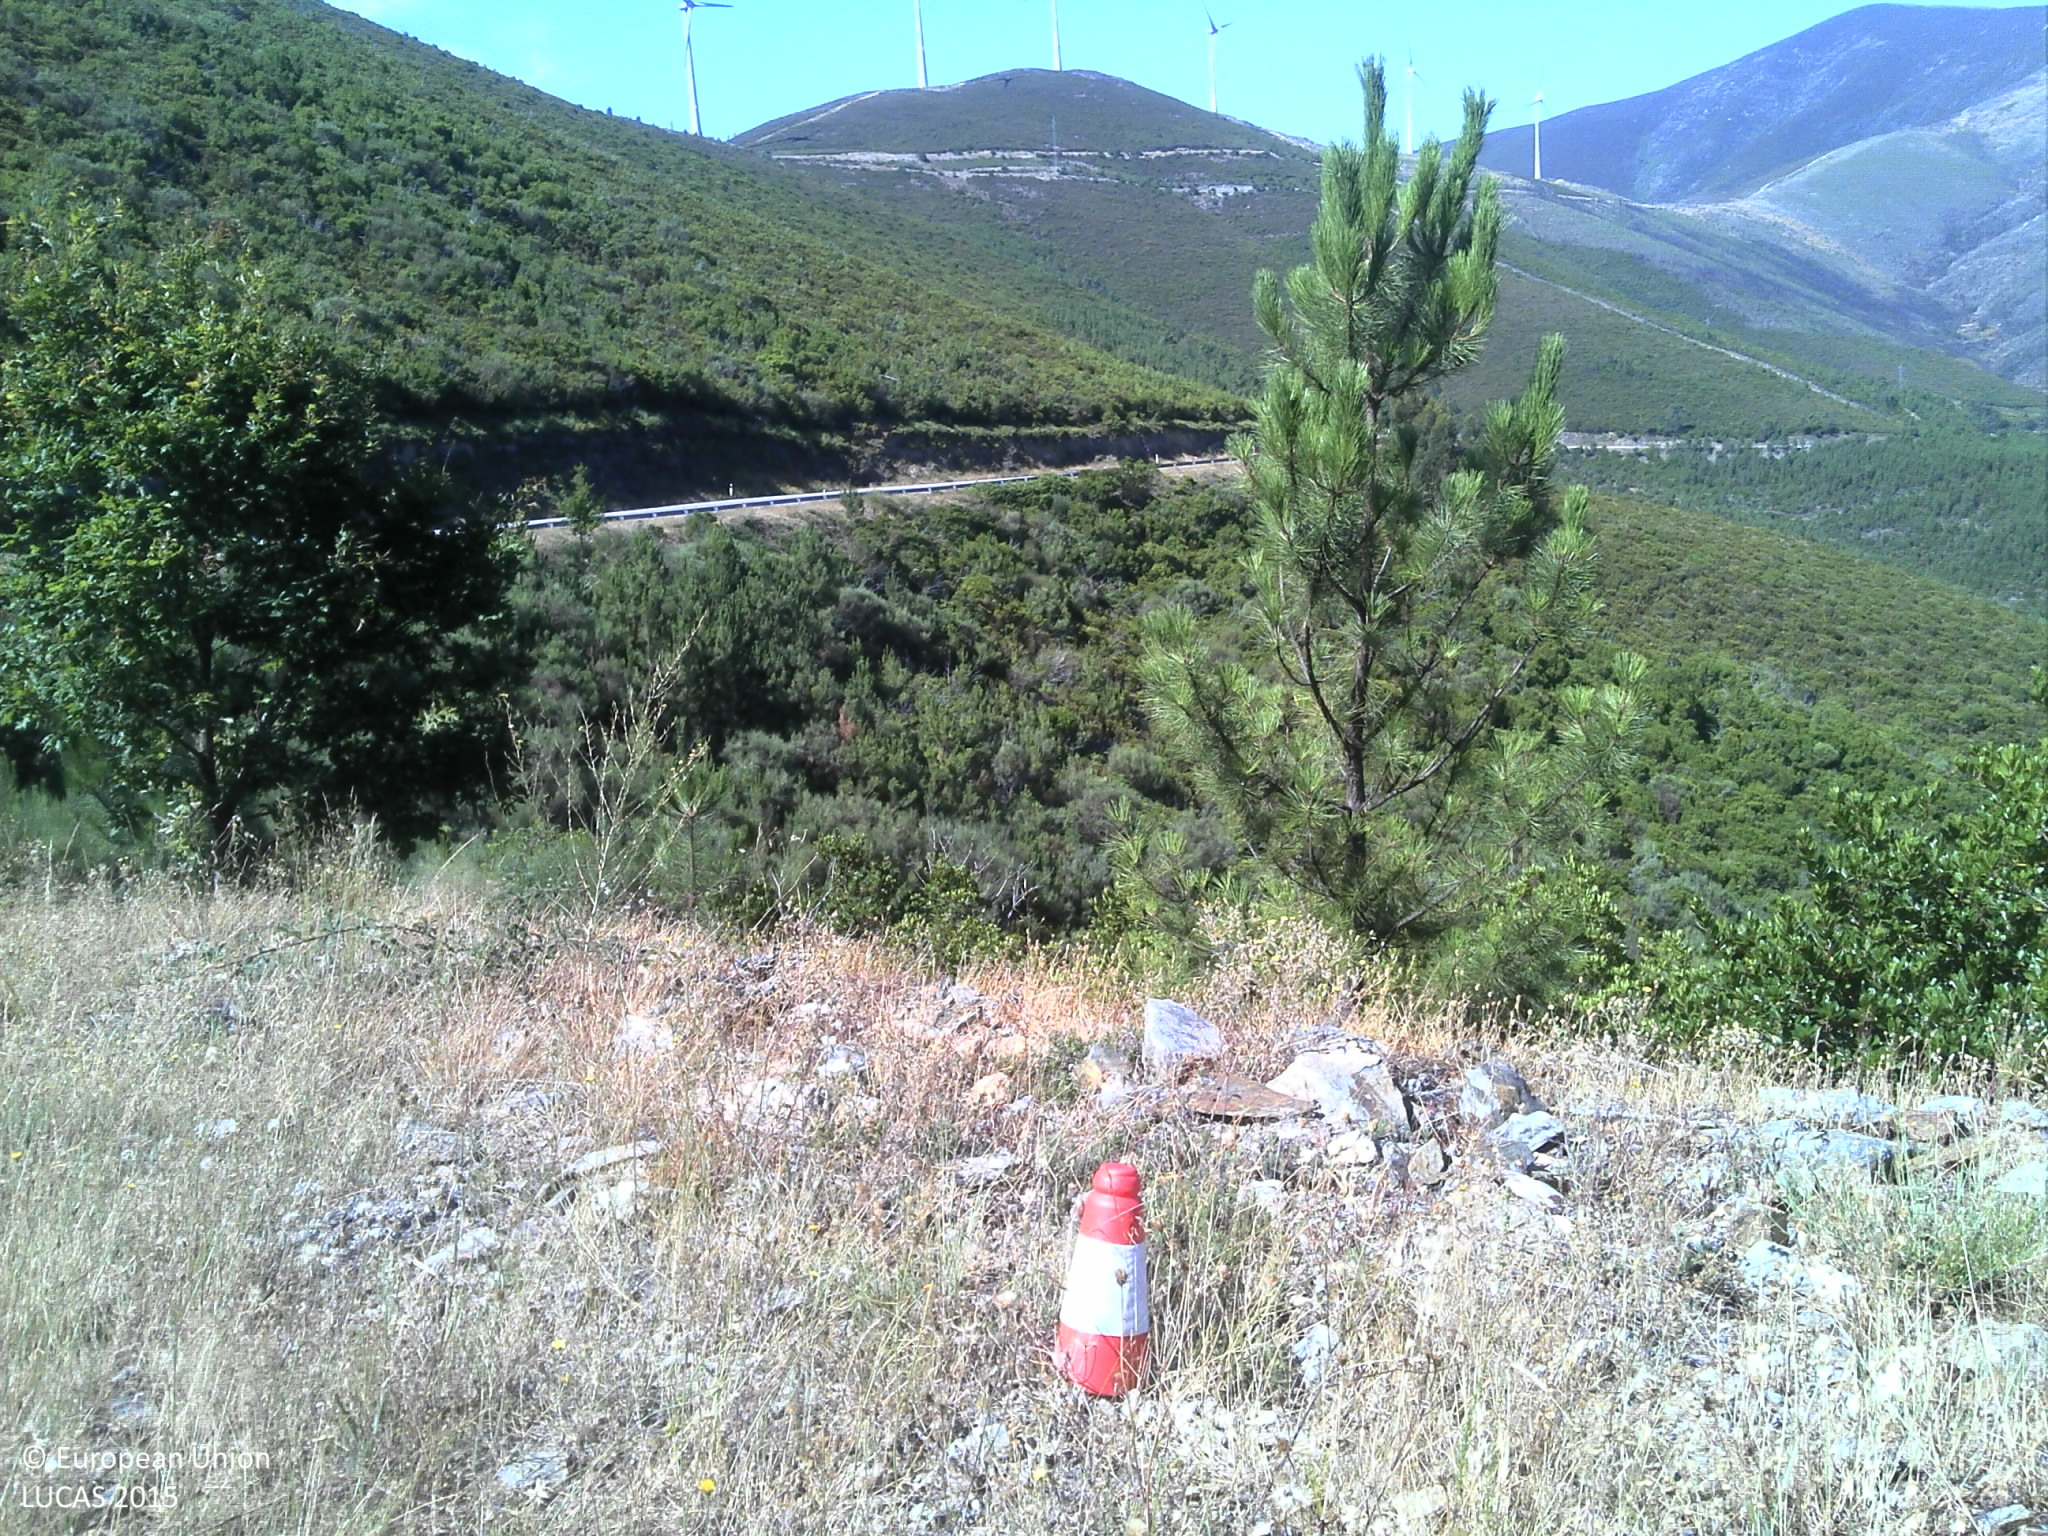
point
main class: Shrubland
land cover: Shrubland with sparse tree cover
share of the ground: 25 - 50 %
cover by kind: shrubs 40 %, herbaceous plants 30 %, unconsolidated bare surface 25 %, broadleaved forest trees 5 %
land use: Semi-natural and natural areas not in use
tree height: > 5 m
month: July
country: PT
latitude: 40.2439
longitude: -7.7335
